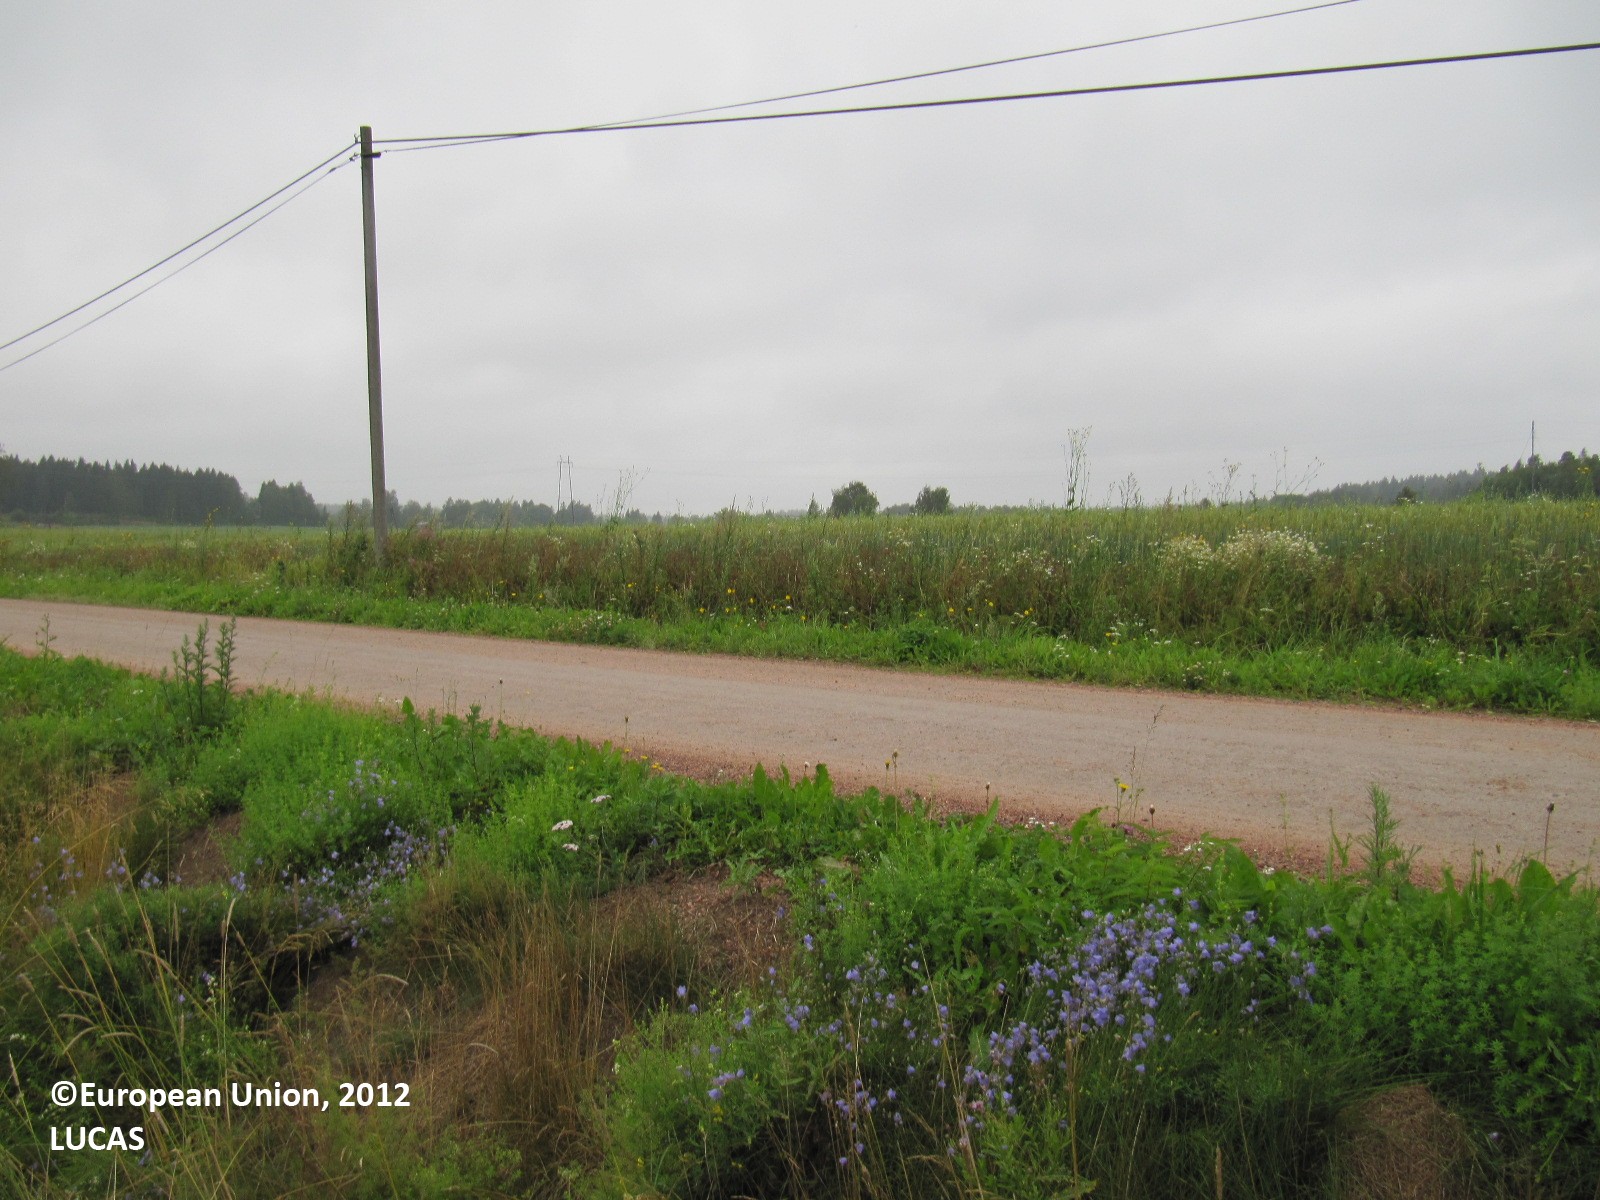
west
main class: Cropland
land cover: Oats
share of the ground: > 75 %
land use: Agriculture (excluding fallow land and kitchen gardens)
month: July
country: FI
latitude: 60.3046
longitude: 23.7927
